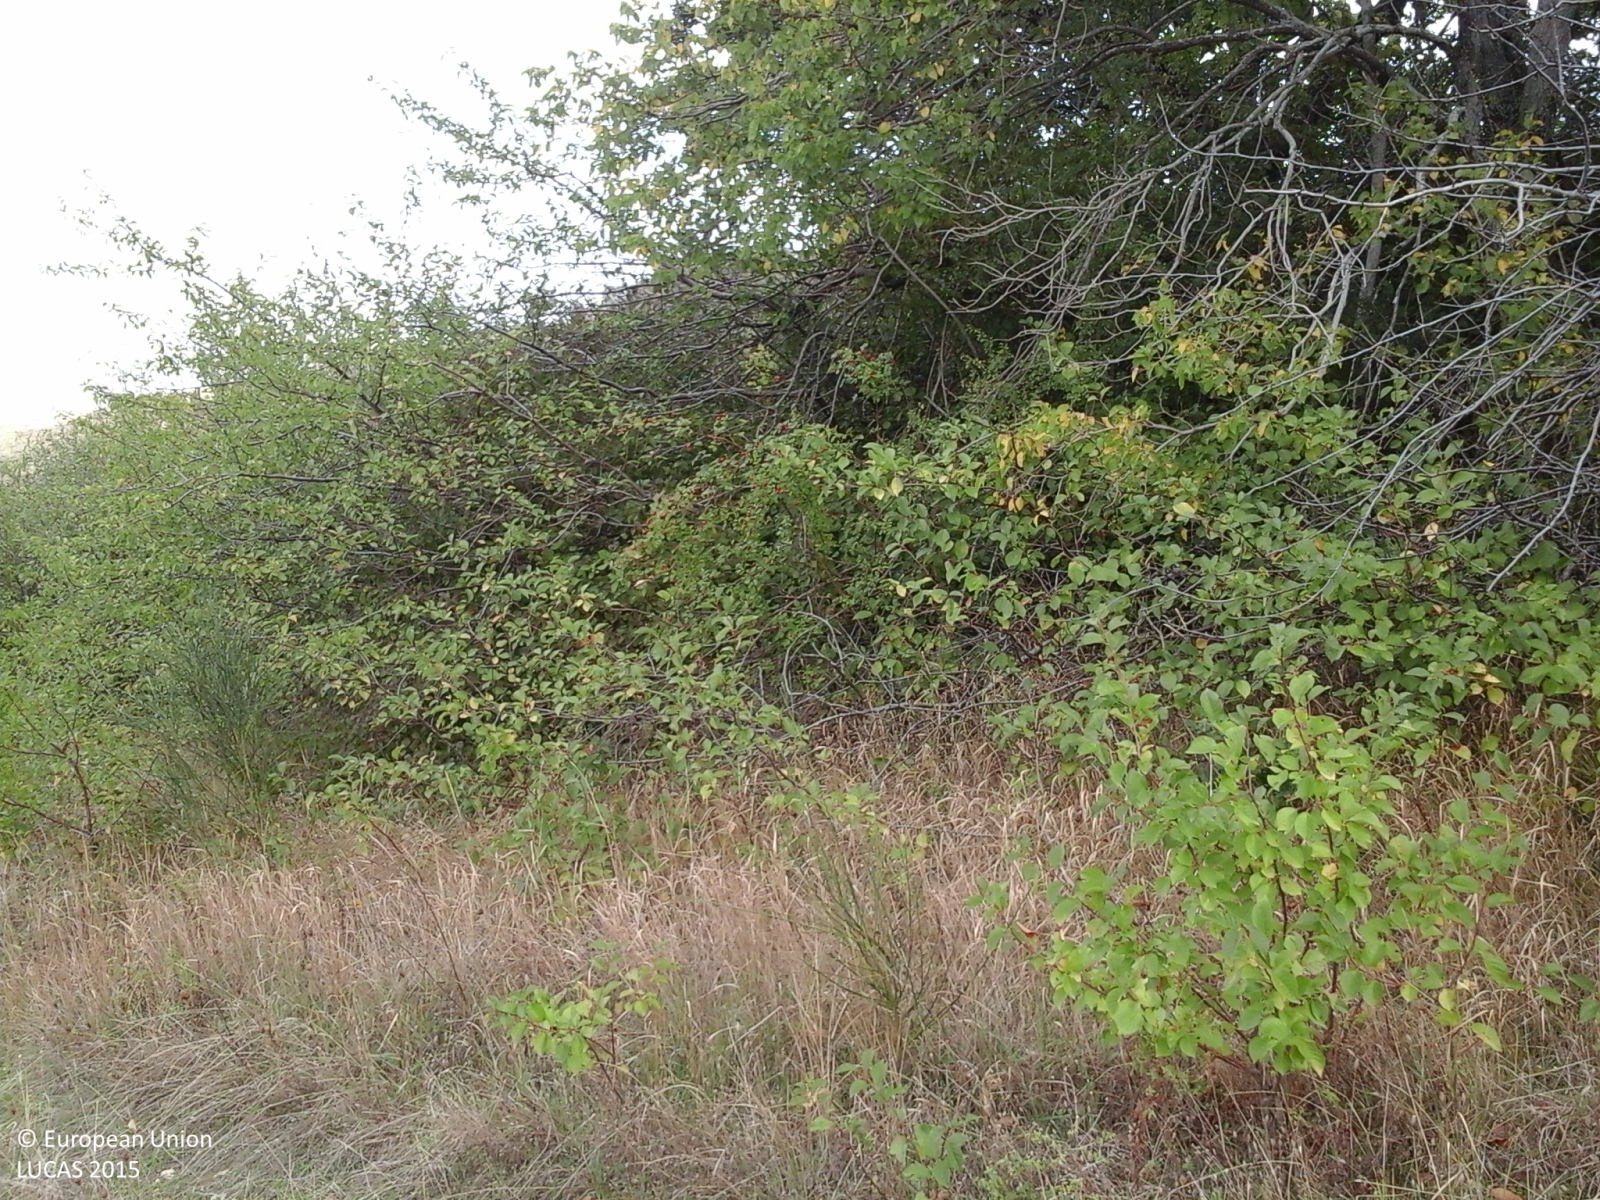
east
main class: Grassland
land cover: Spontaneously vegetated surfaces
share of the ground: > 75 %
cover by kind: herbaceous plants 100 %
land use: Fallow land
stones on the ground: < 10 %
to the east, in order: Spontaneously vegetated surfaces; Broadleaved woodland; Spontaneously vegetated surfaces; Olive groves; Shrubland with sparse tree cover; Shrubland without tree cover; Tracks; Shrubland without tree cover; Paved roads, cycling and walking lanes; Broadleaved woodland; Dry pulses
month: October
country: IT
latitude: 41.5107
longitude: 15.1228
